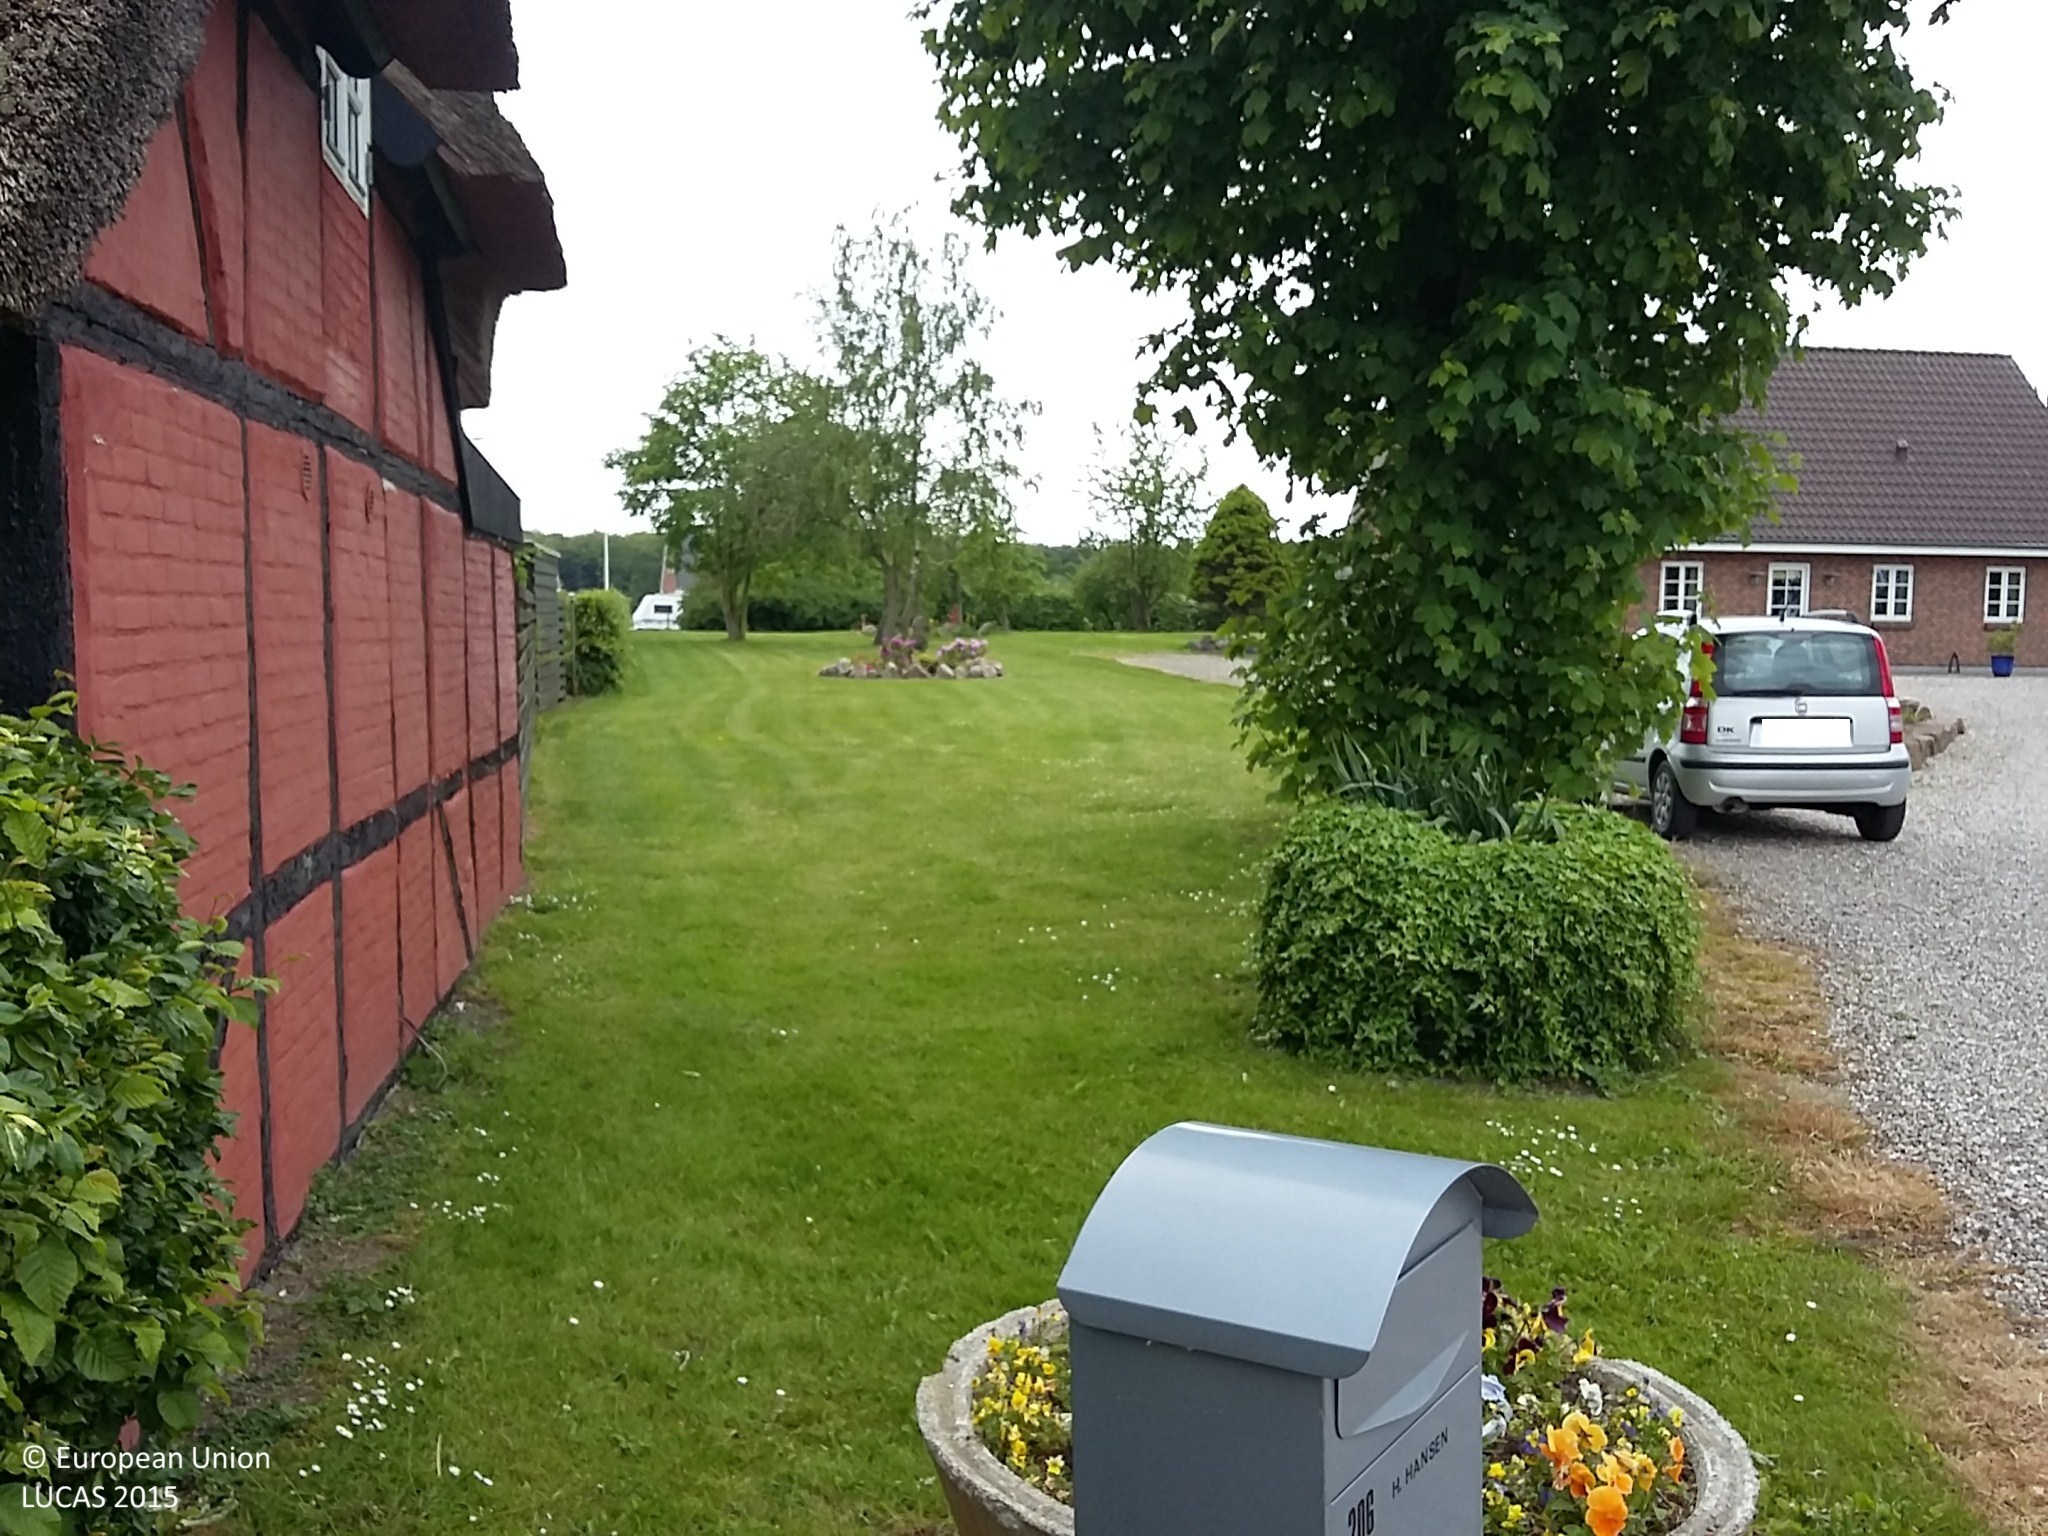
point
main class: Woodland
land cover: Broadleaved woodland
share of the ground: 25 - 50 %
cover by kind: herbaceous plants 60 %, broadleaved forest trees 40 %
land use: Residential
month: June
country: DK
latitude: 55.4313
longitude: 10.6158
